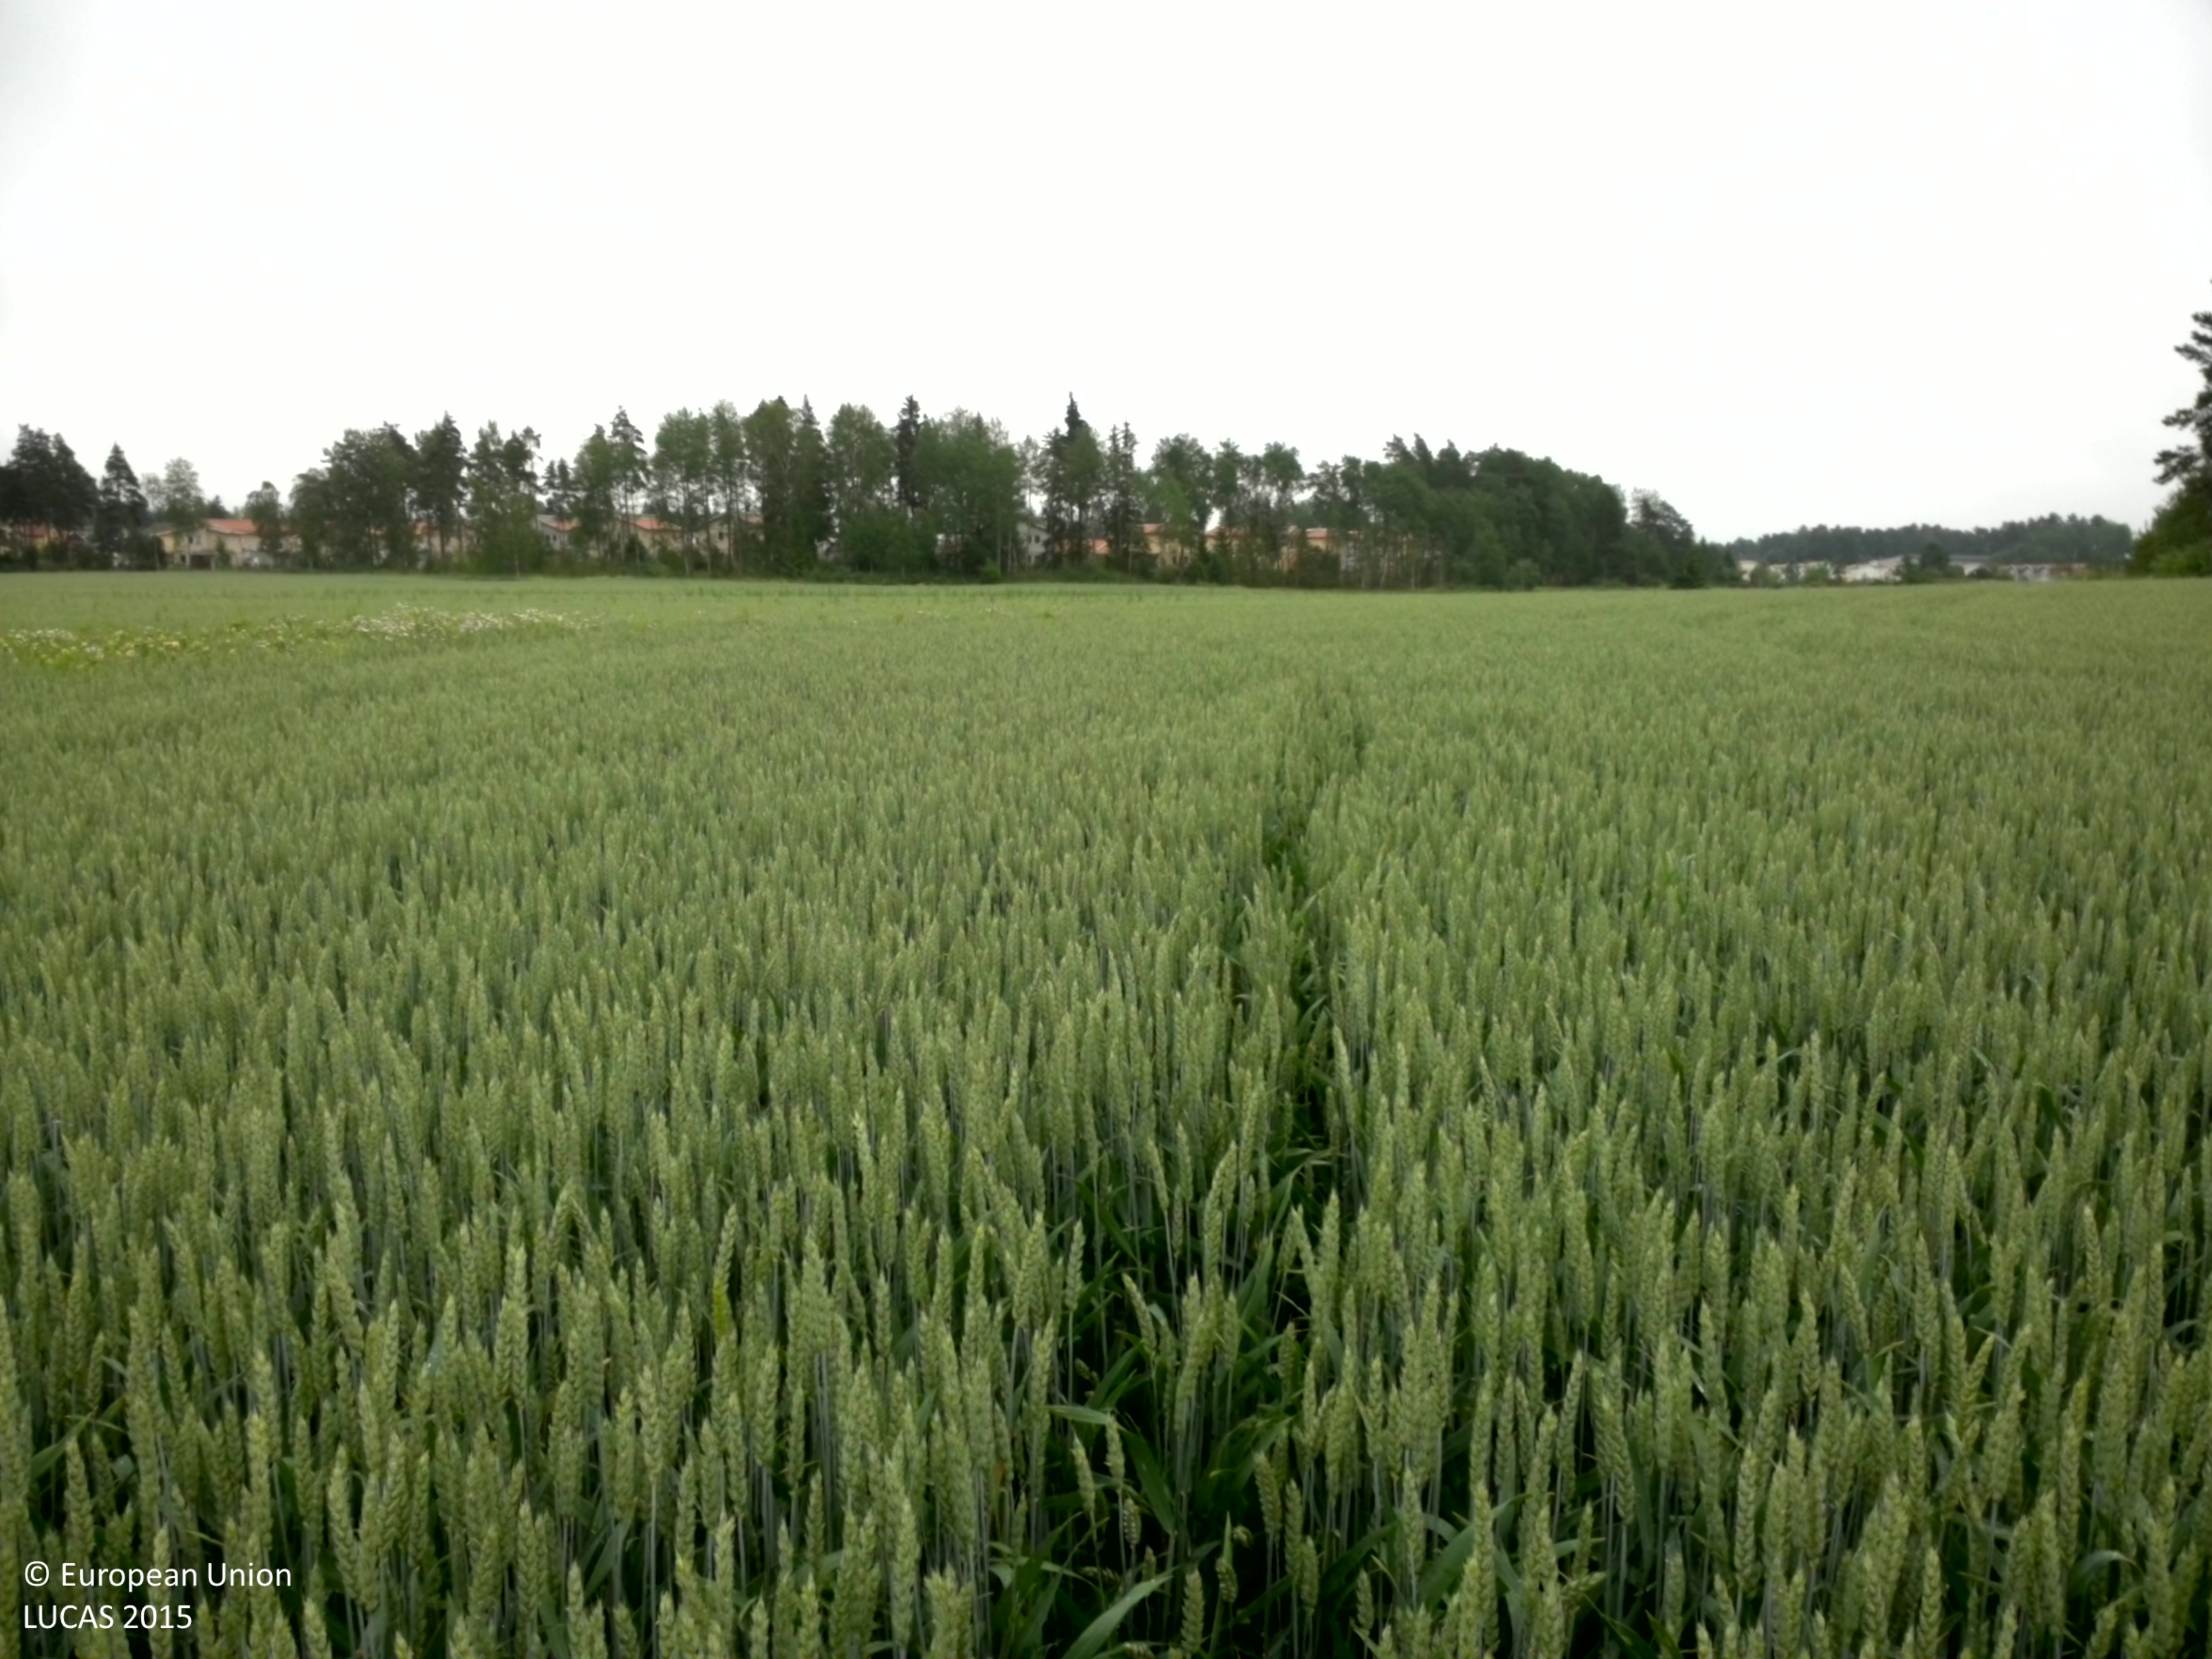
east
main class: Cropland
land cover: Common wheat
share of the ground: > 75 %
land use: Agriculture (excluding fallow land and kitchen gardens)
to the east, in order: Common wheat; Ditches and canals; Broadleaved woodland; Paved roads, cycling and walking lanes; Pine dominated mixed woodland; Artificial constructions in urban areas
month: July
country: SE
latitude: 59.8520
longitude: 17.5448
